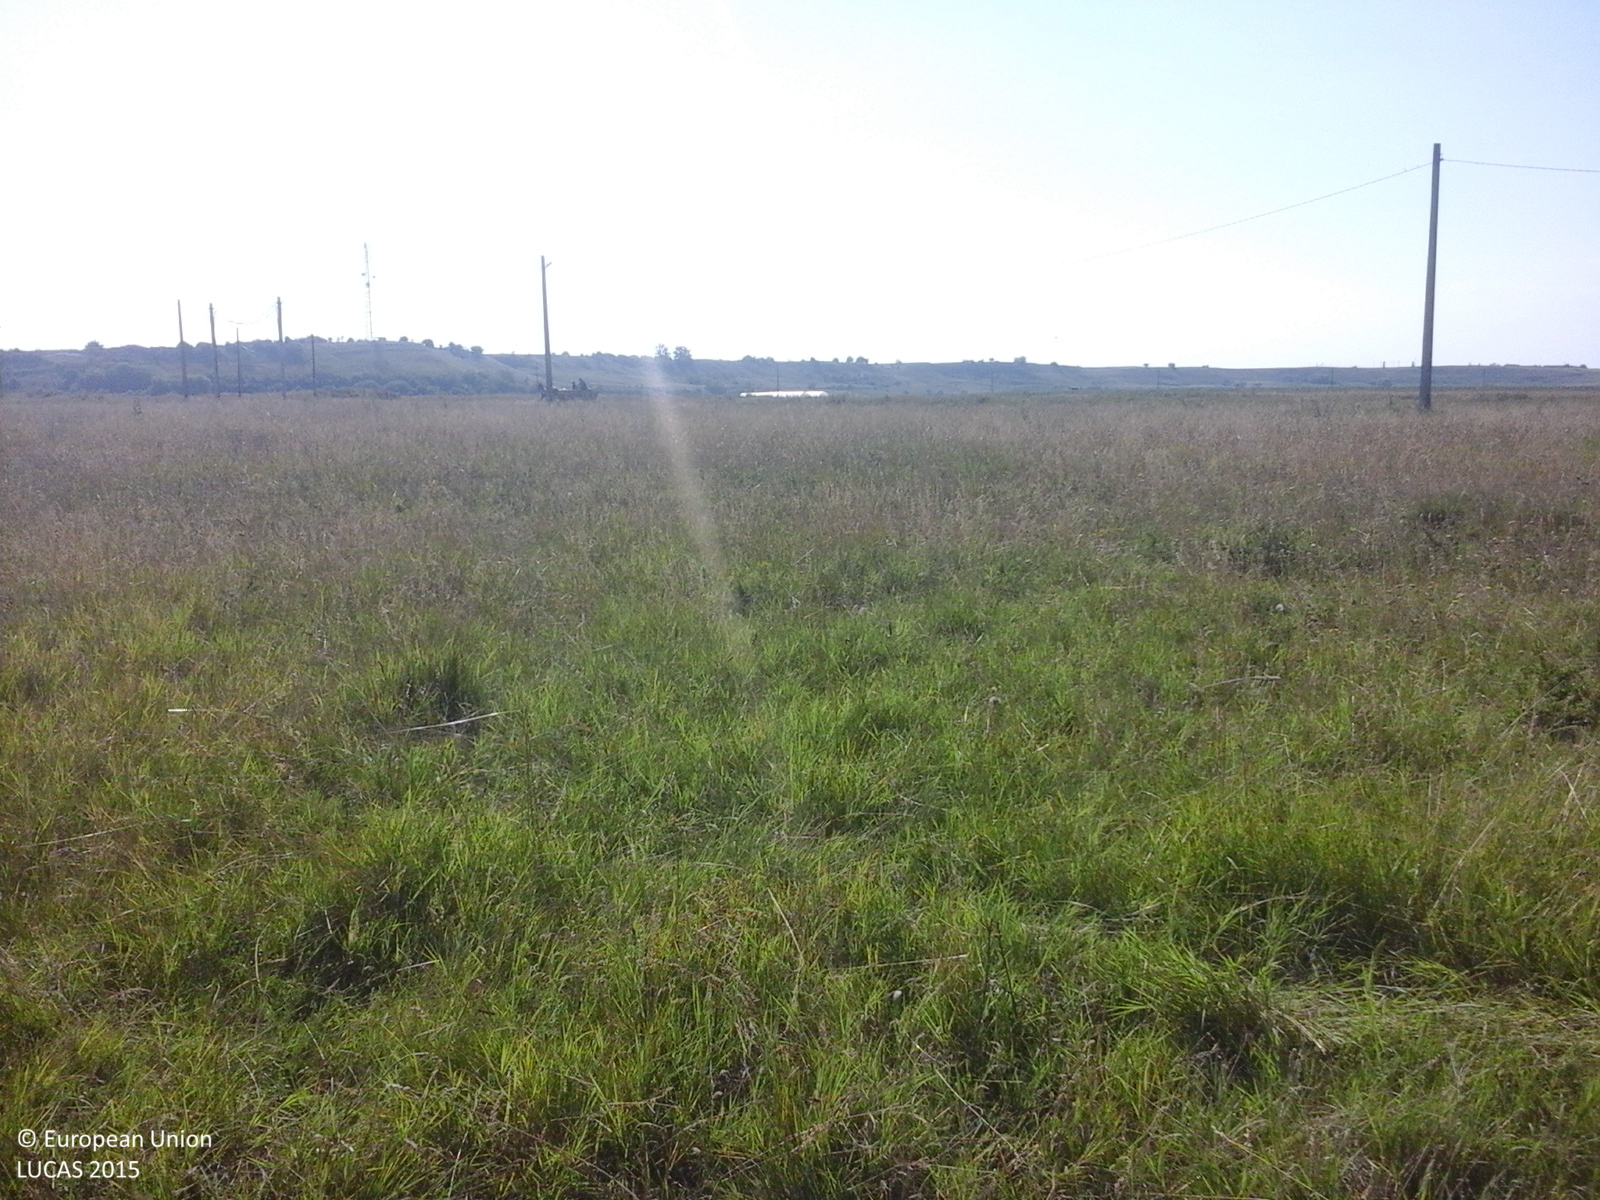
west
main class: Grassland
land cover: Grassland without tree/shrub cover
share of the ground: > 75 %
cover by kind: herbaceous plants 100 %
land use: Agriculture (excluding fallow land and kitchen gardens)
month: July
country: RO
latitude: 44.2642
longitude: 24.3336
